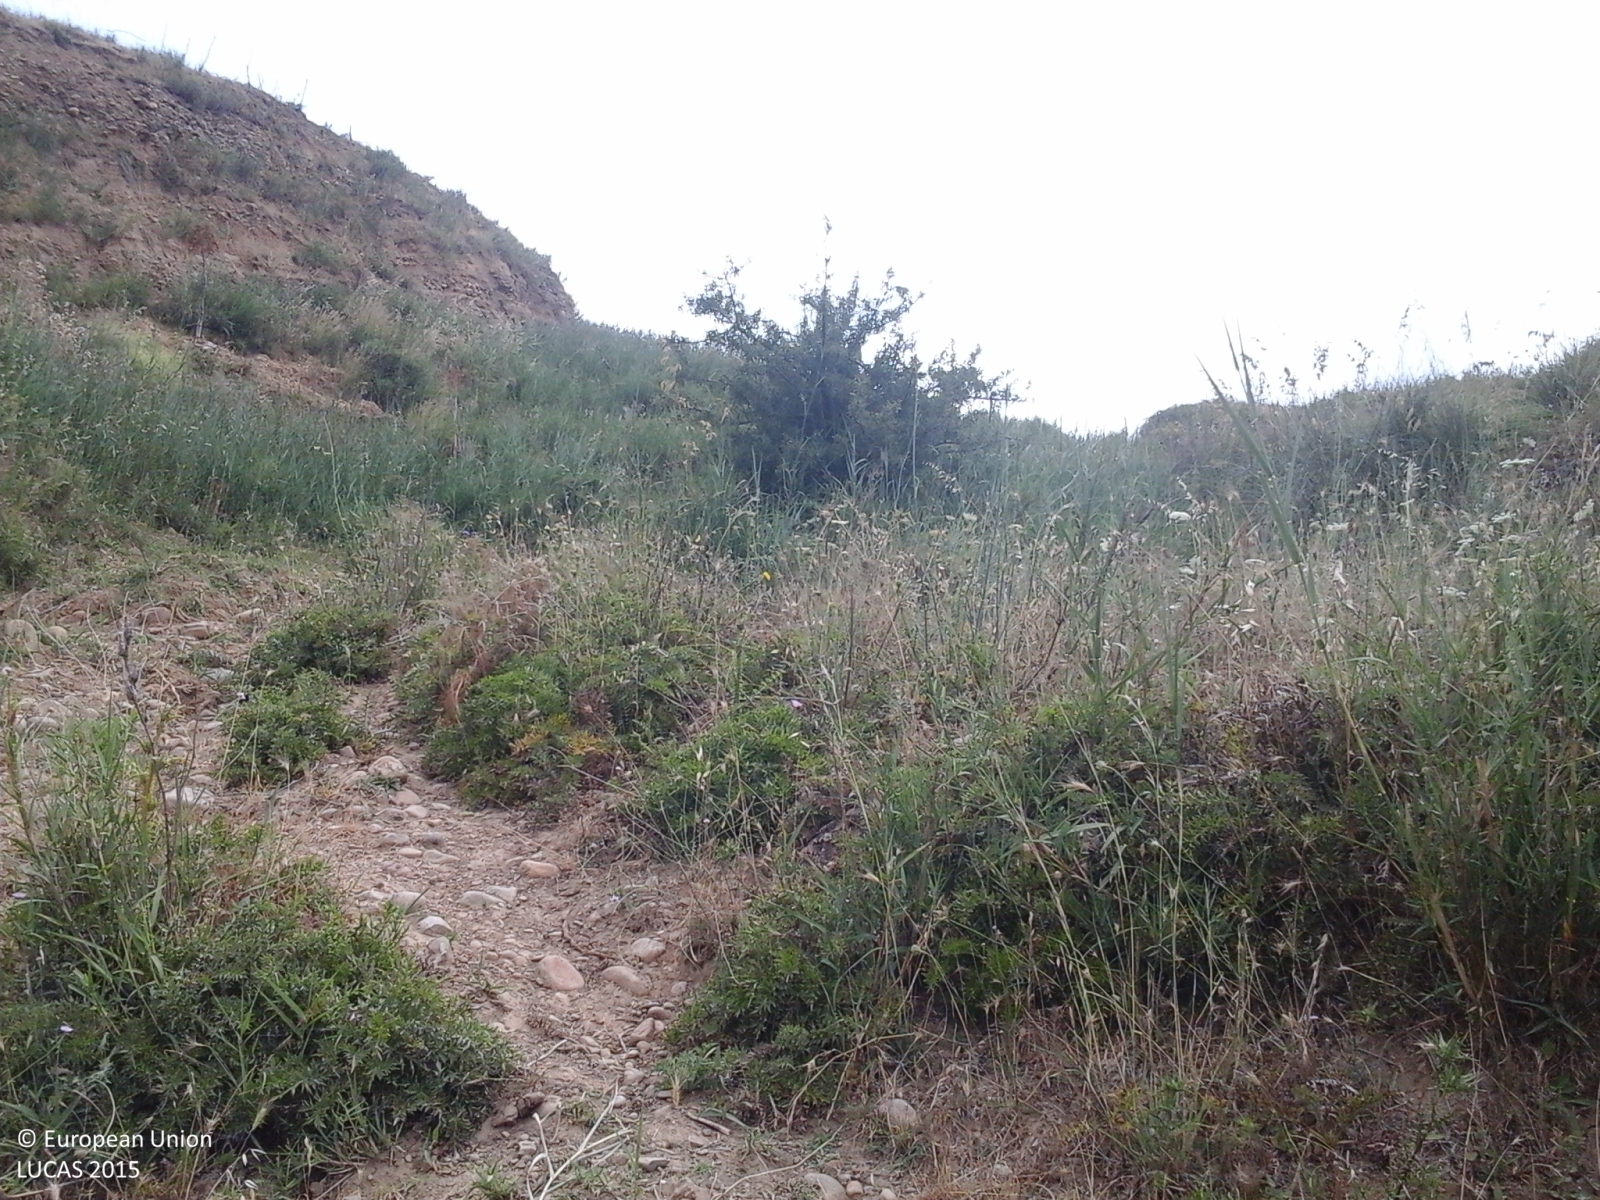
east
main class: Grassland
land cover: Grassland without tree/shrub cover
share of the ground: > 75 %
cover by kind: herbaceous plants 100 %
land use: Agriculture (excluding fallow land and kitchen gardens)
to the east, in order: Grassland without tree/shrub cover; Fences; Temporary grasslands; Fences; Grass margins; Paved roads, cycling and walking lanes; Grassland with sparse tree/shrub cover; Fences; Oats
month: June
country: IT
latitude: 37.8757
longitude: 13.6912
